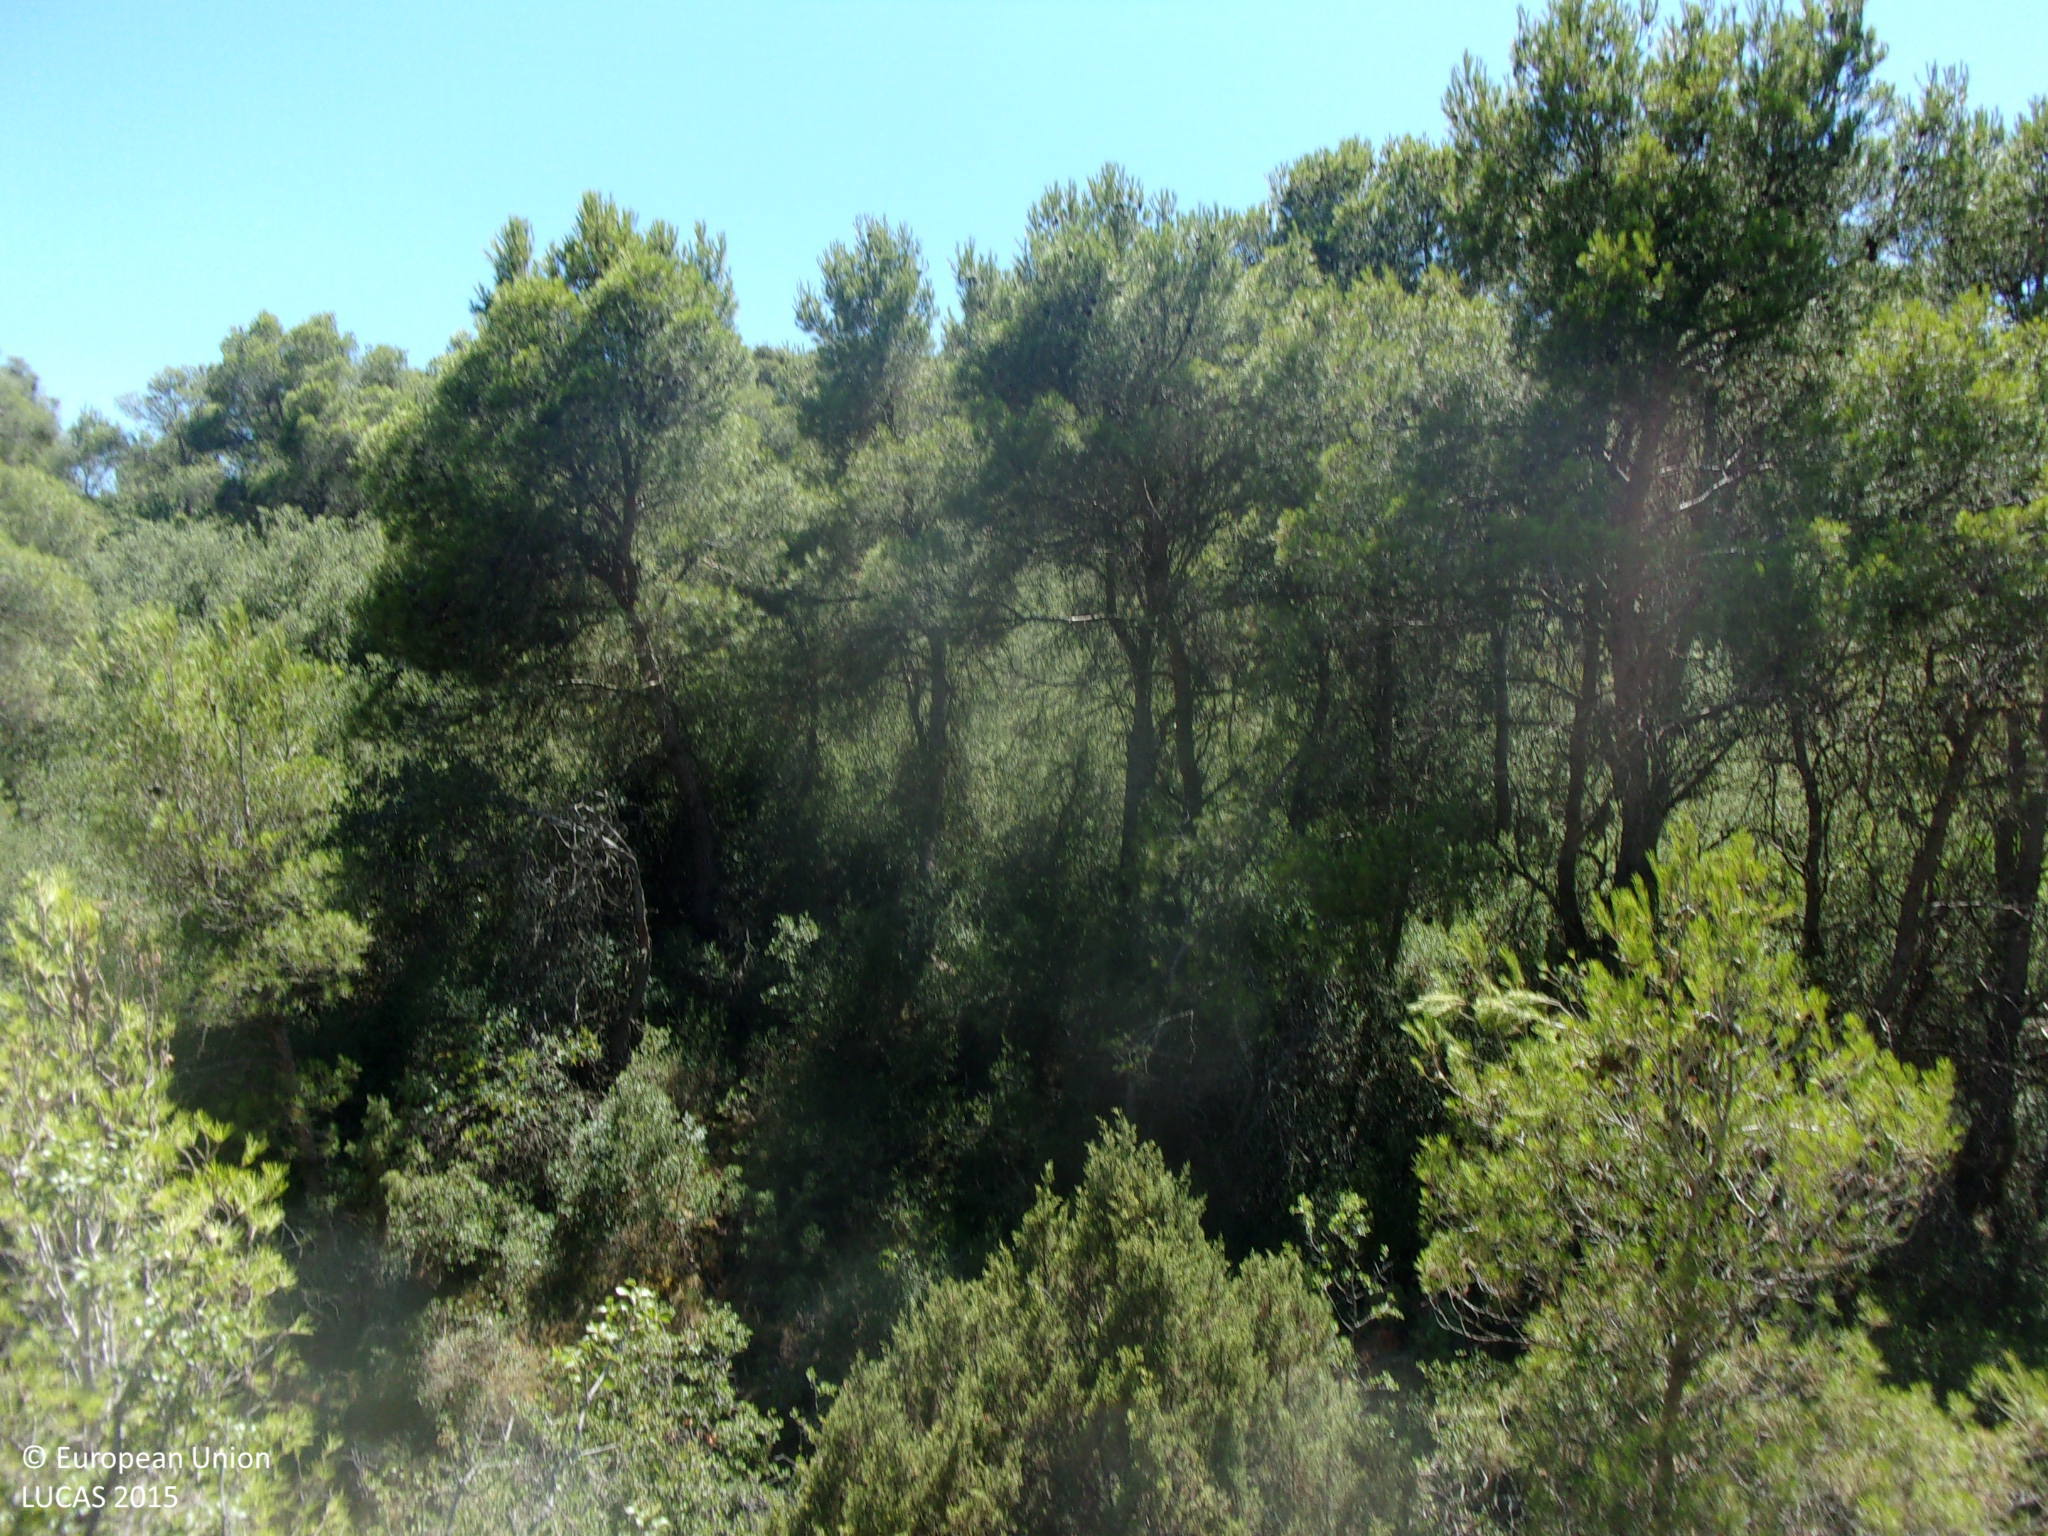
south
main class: Woodland
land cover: Pine dominated coniferous woodland
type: coniferous forest of the mediterranean region
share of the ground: 25 - 50 %
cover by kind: shrubs 70 %, coniferous forest trees 30 %
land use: Forestry
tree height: < 5 m
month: July
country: ES
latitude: 42.0494
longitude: -1.0334
